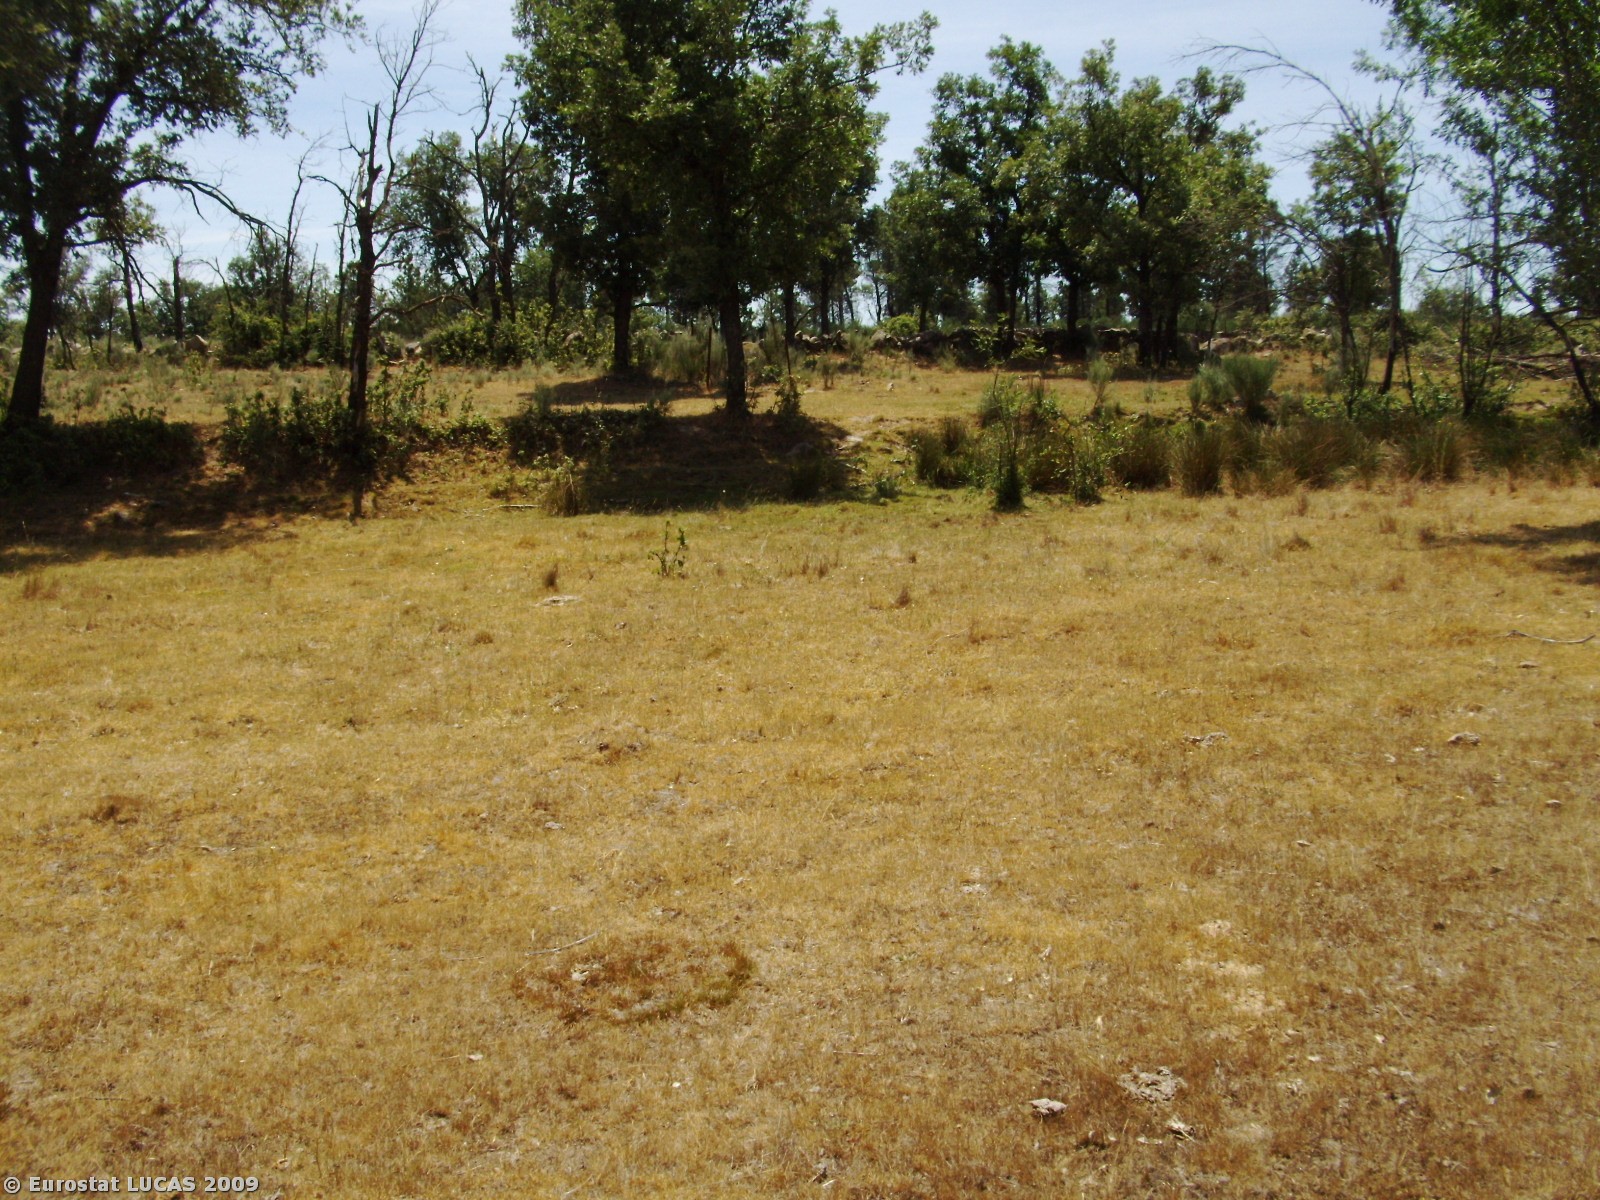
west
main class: Grassland
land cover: Spontaneously vegetated surfaces
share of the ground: > 75 %
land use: Fallow land
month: July
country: PT
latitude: 40.4149
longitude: -6.9848
